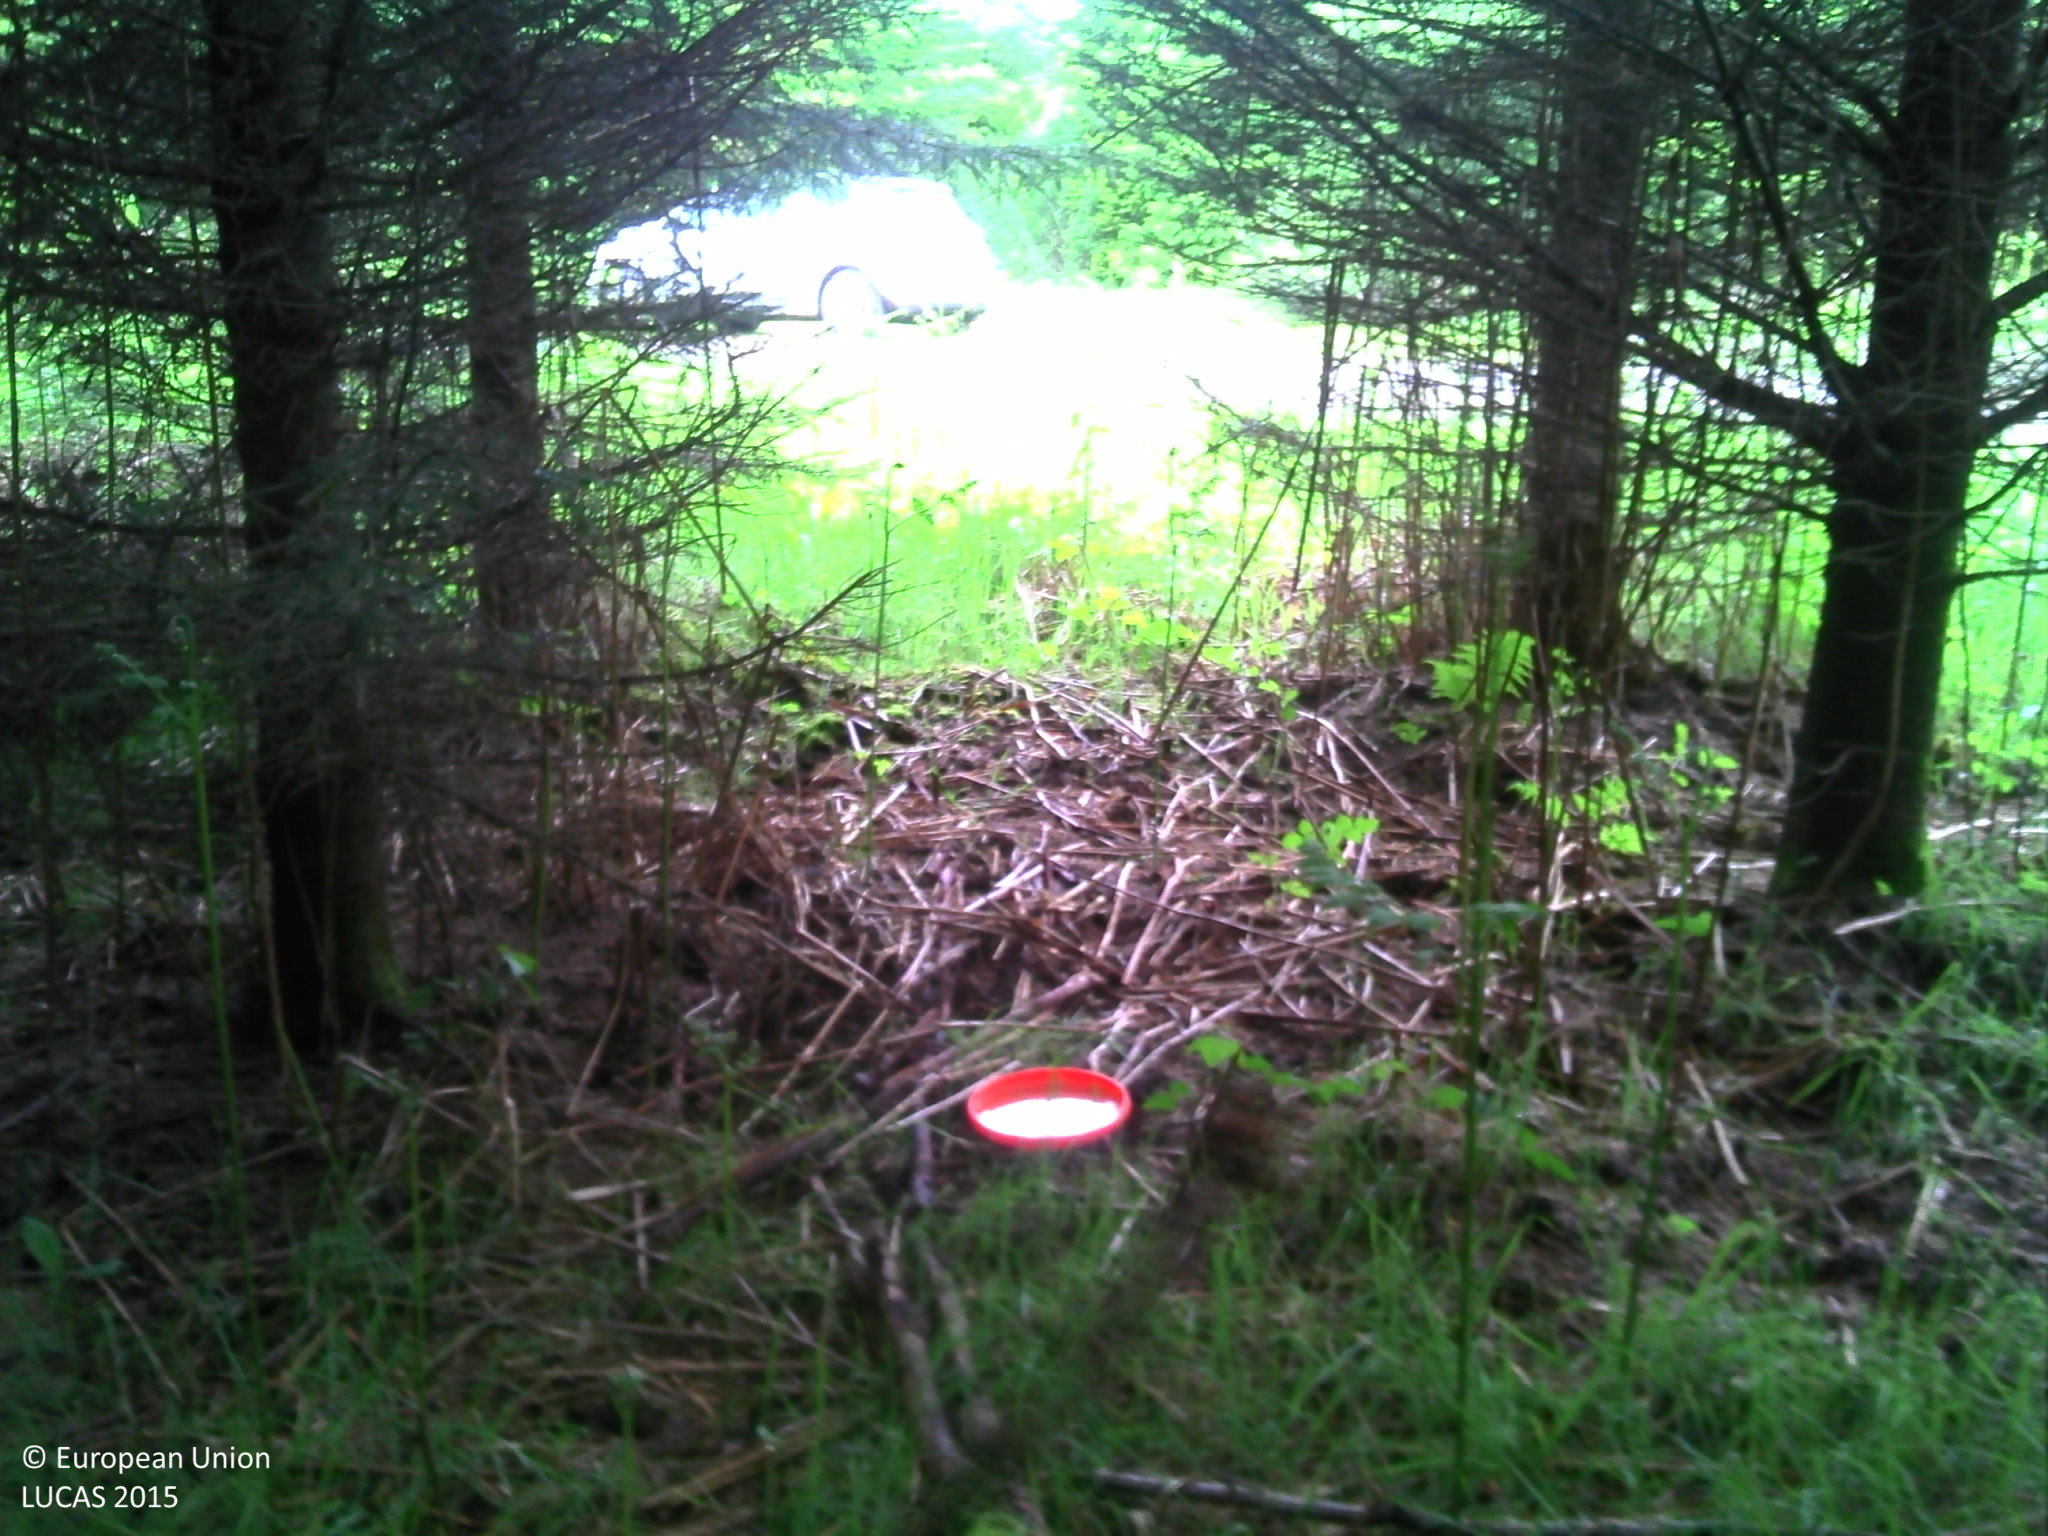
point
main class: Woodland
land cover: Spruce dominated coniferous woodland
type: exotic forest
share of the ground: > 75 %
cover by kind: coniferous forest trees 85 %, herbaceous plants 15 %
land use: Forestry
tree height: > 5 m
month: June
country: BE
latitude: 49.9420
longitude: 4.8552
